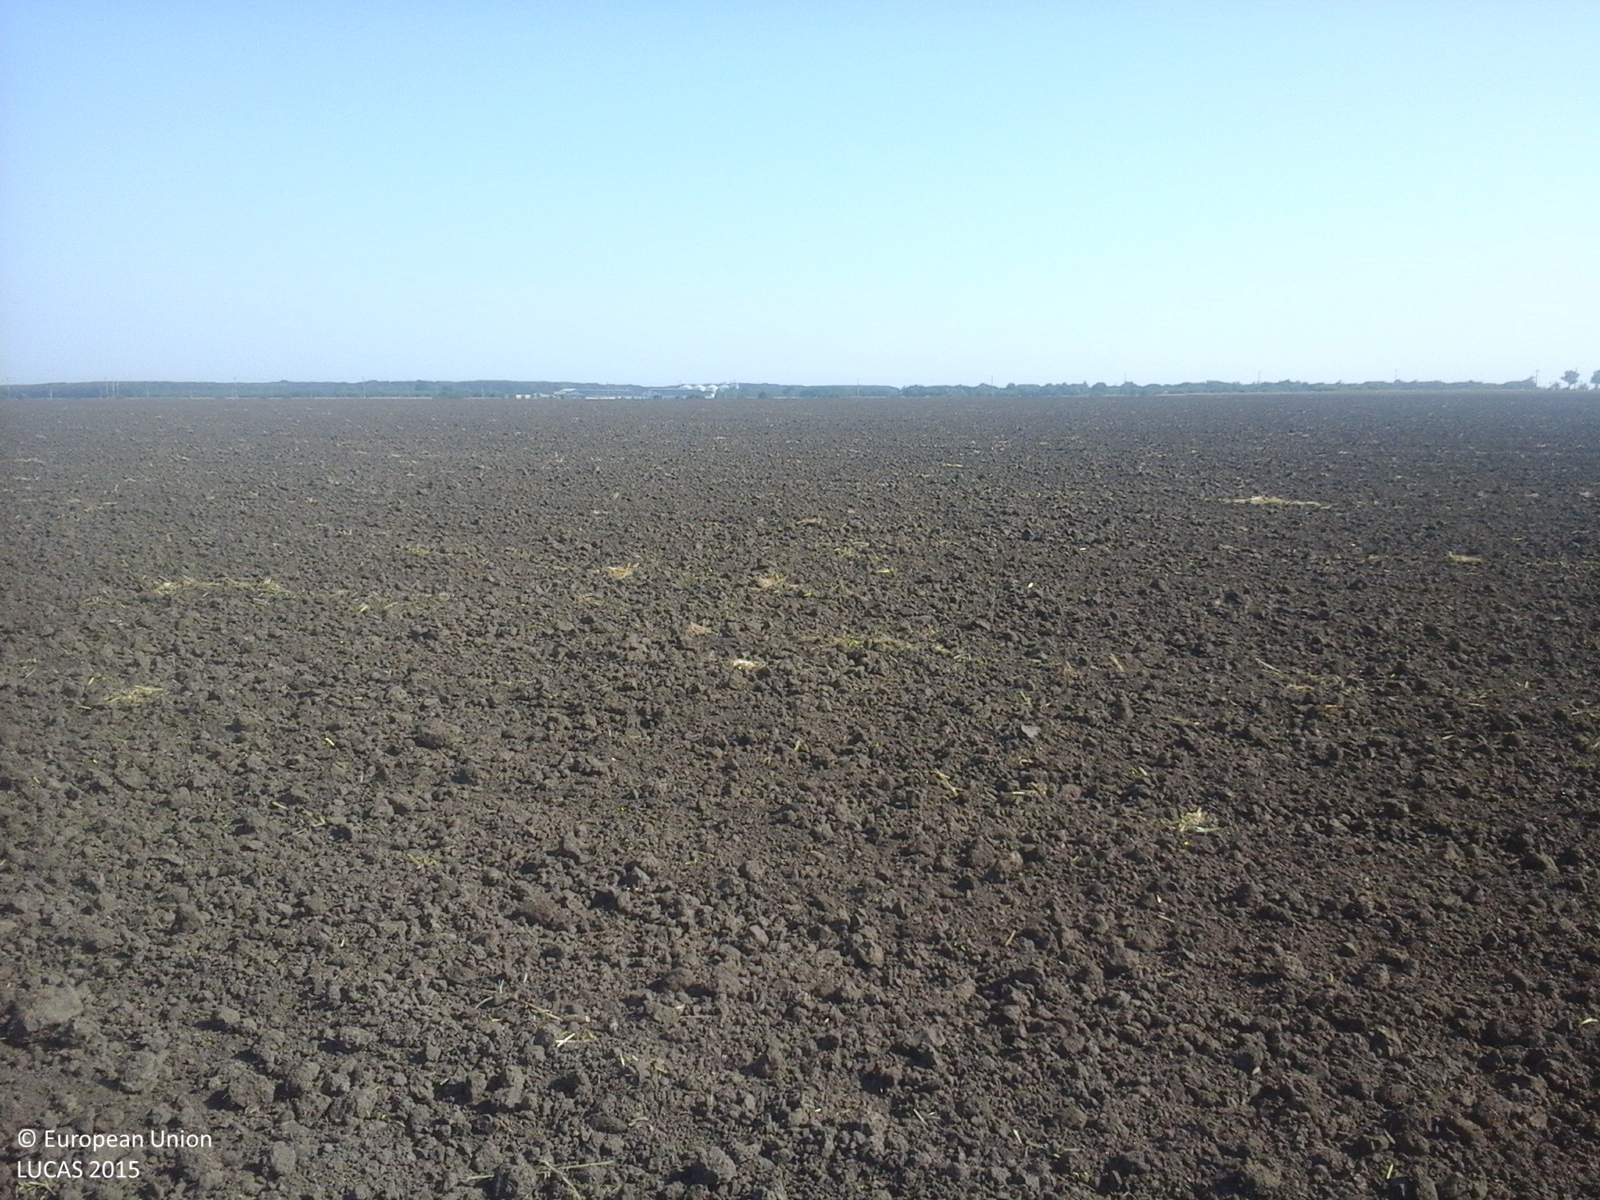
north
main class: Cropland
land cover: Durum wheat
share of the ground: < 10 %
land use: Agriculture (excluding fallow land and kitchen gardens)
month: July
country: RO
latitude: 44.3408
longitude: 27.1778
